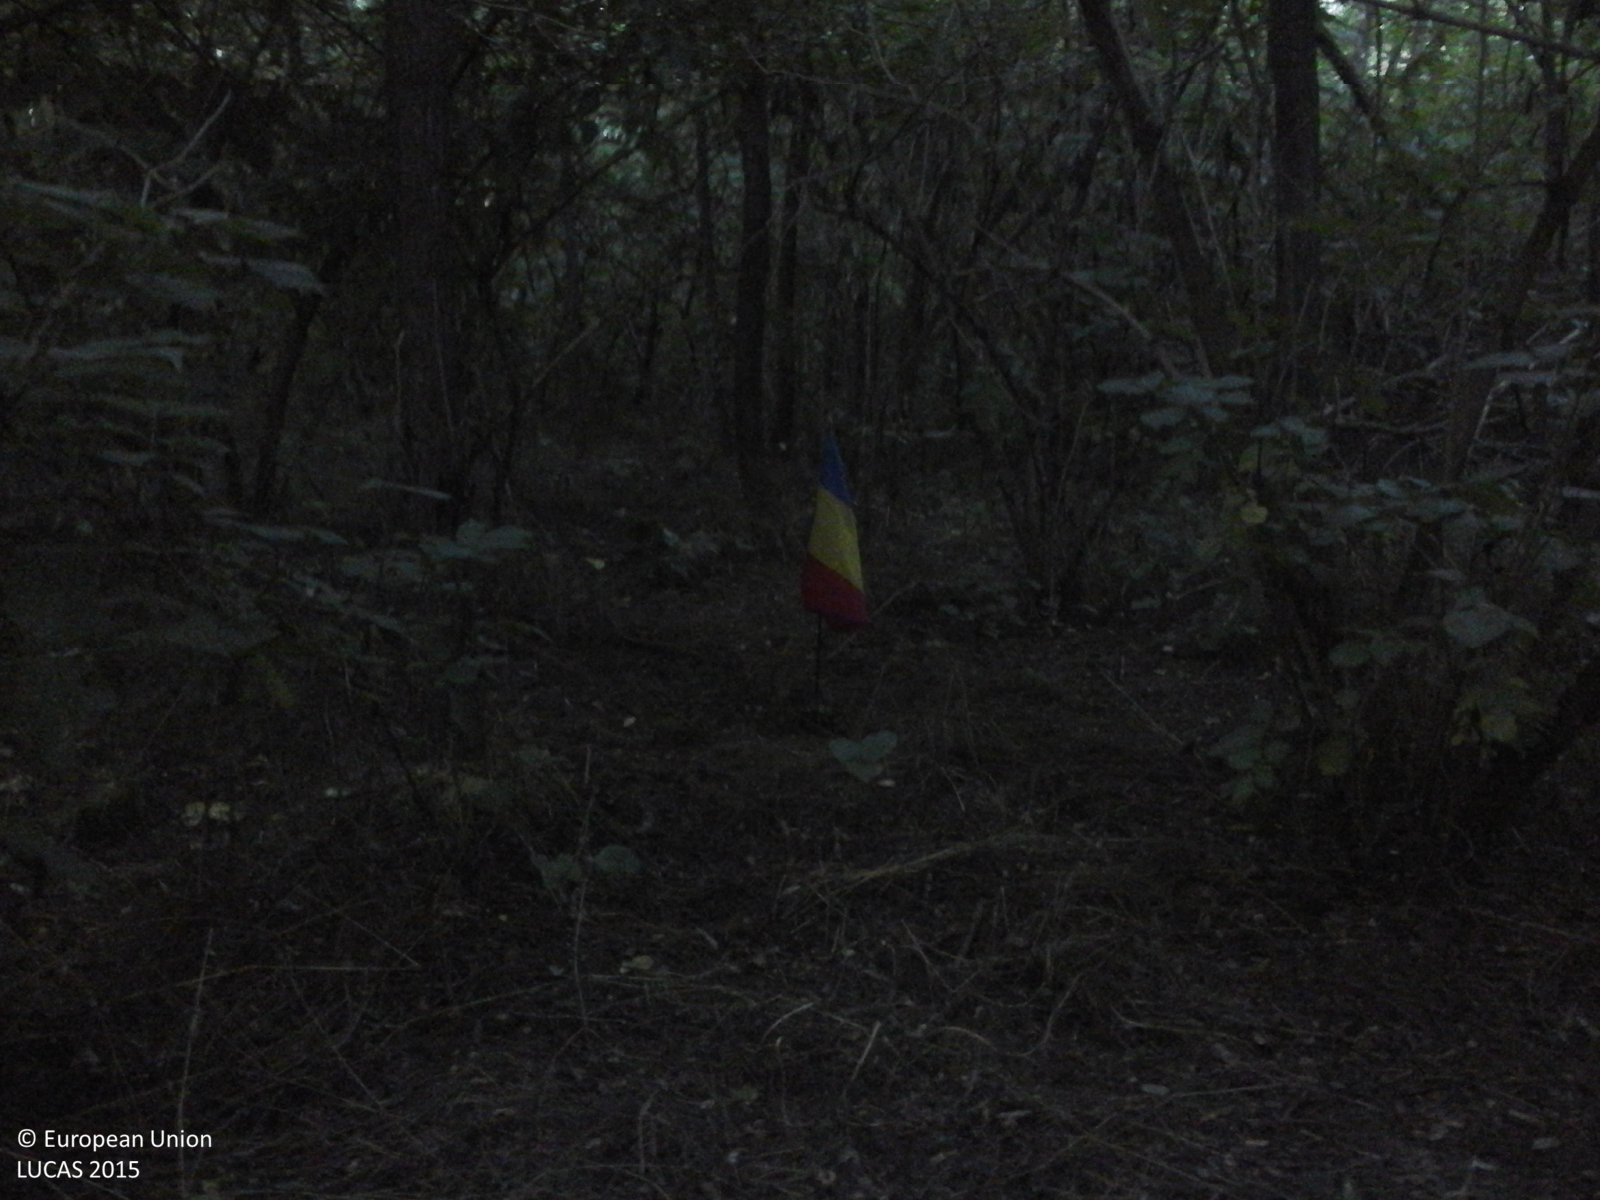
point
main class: Woodland
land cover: Broadleaved woodland
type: exotic forest
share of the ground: > 75 %
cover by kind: broadleaved forest trees 100 %
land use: Forestry
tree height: > 5 m
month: June
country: RO
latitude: 47.6338
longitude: 27.2948
